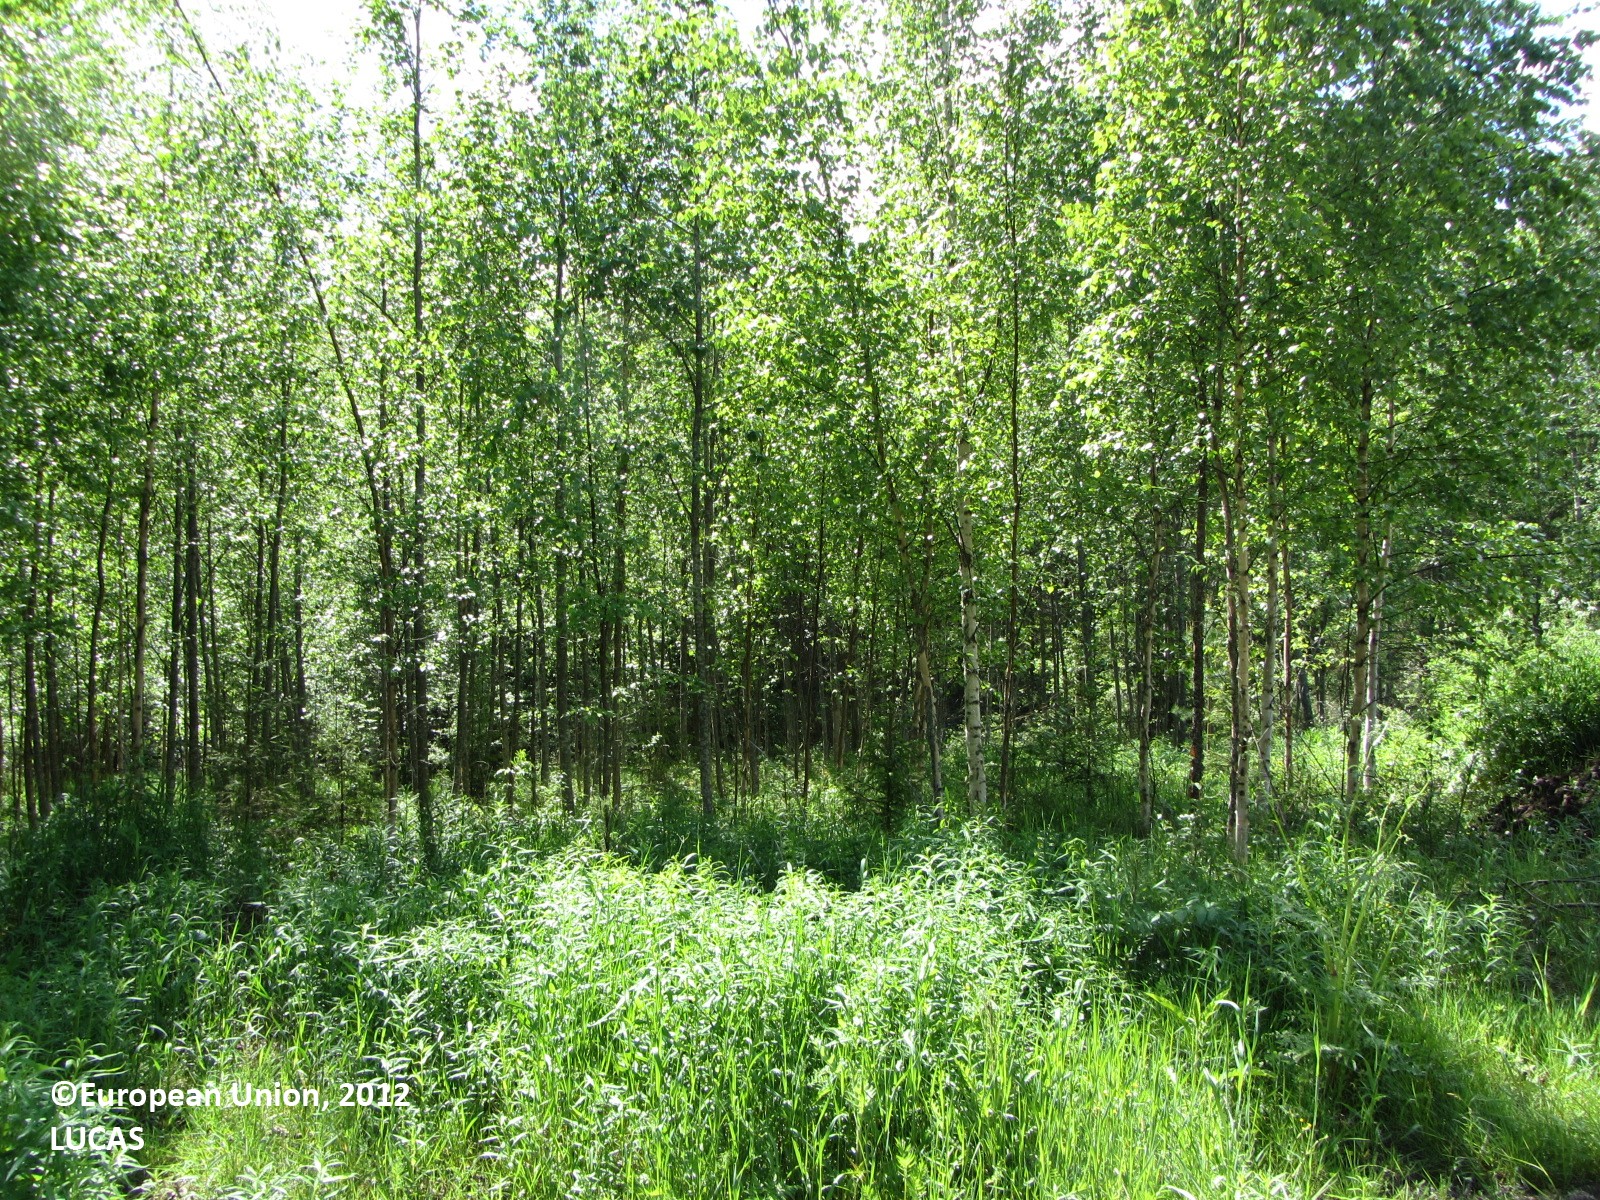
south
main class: Grassland
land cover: Spontaneously vegetated surfaces
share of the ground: 50 - 75 %
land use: Semi-natural and natural areas not in use
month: June
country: FI
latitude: 61.9953
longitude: 24.7030
